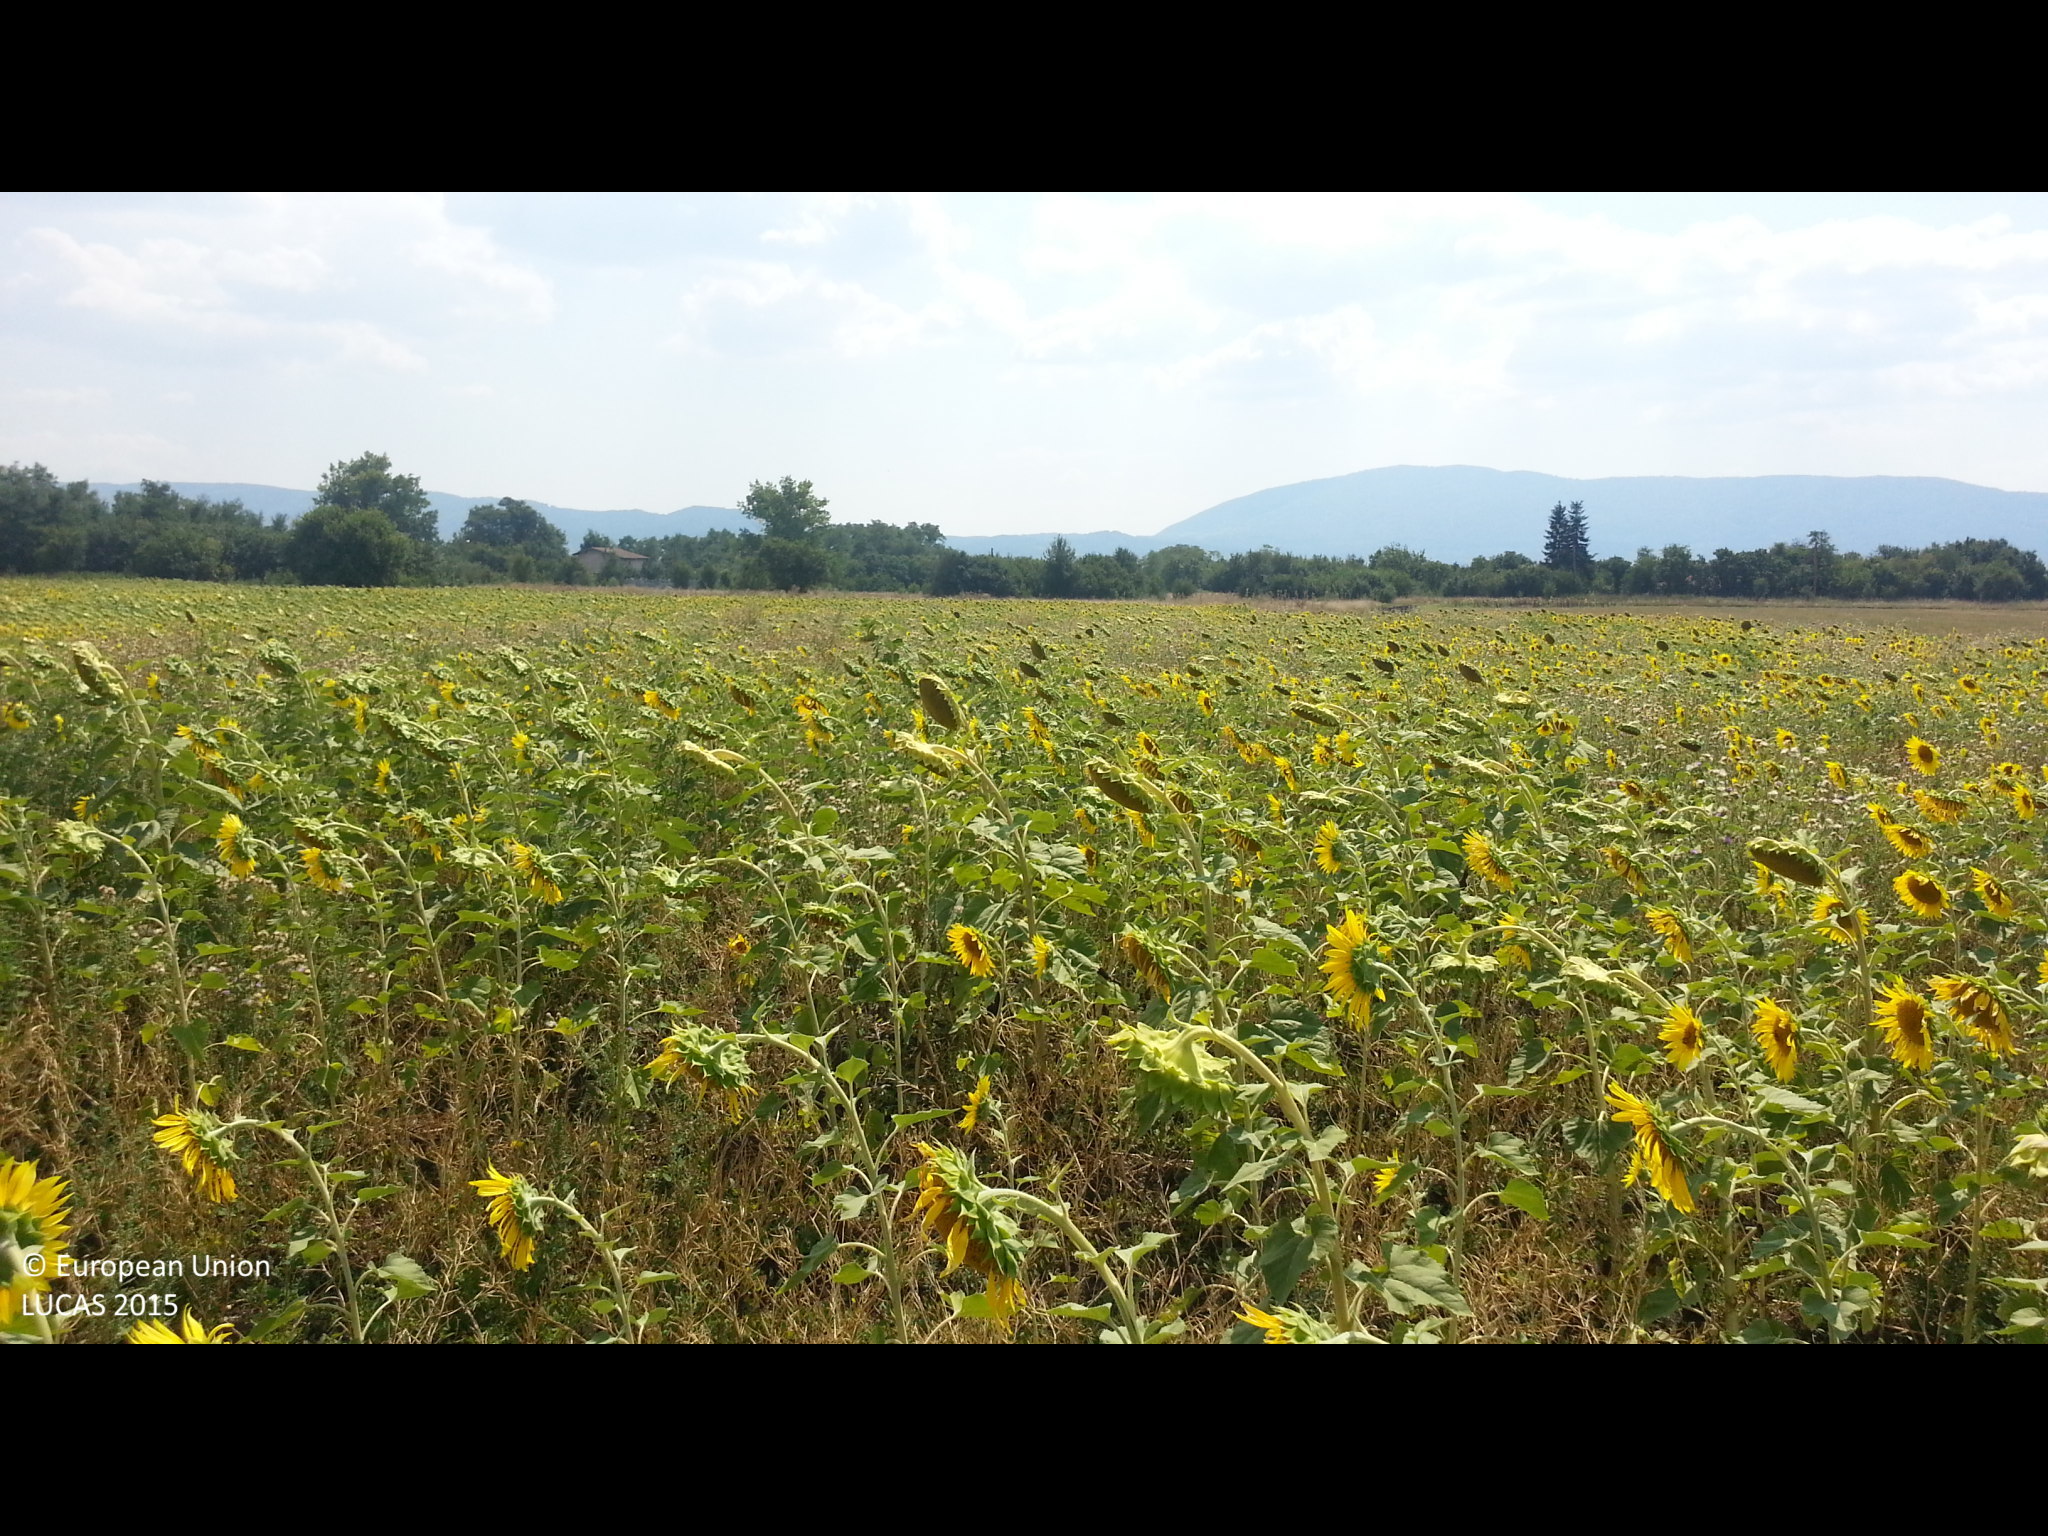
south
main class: Cropland
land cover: Sunflower
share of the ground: 50 - 75 %
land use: Agriculture (excluding fallow land and kitchen gardens)
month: August
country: BG
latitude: 42.4755
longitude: 22.9571
